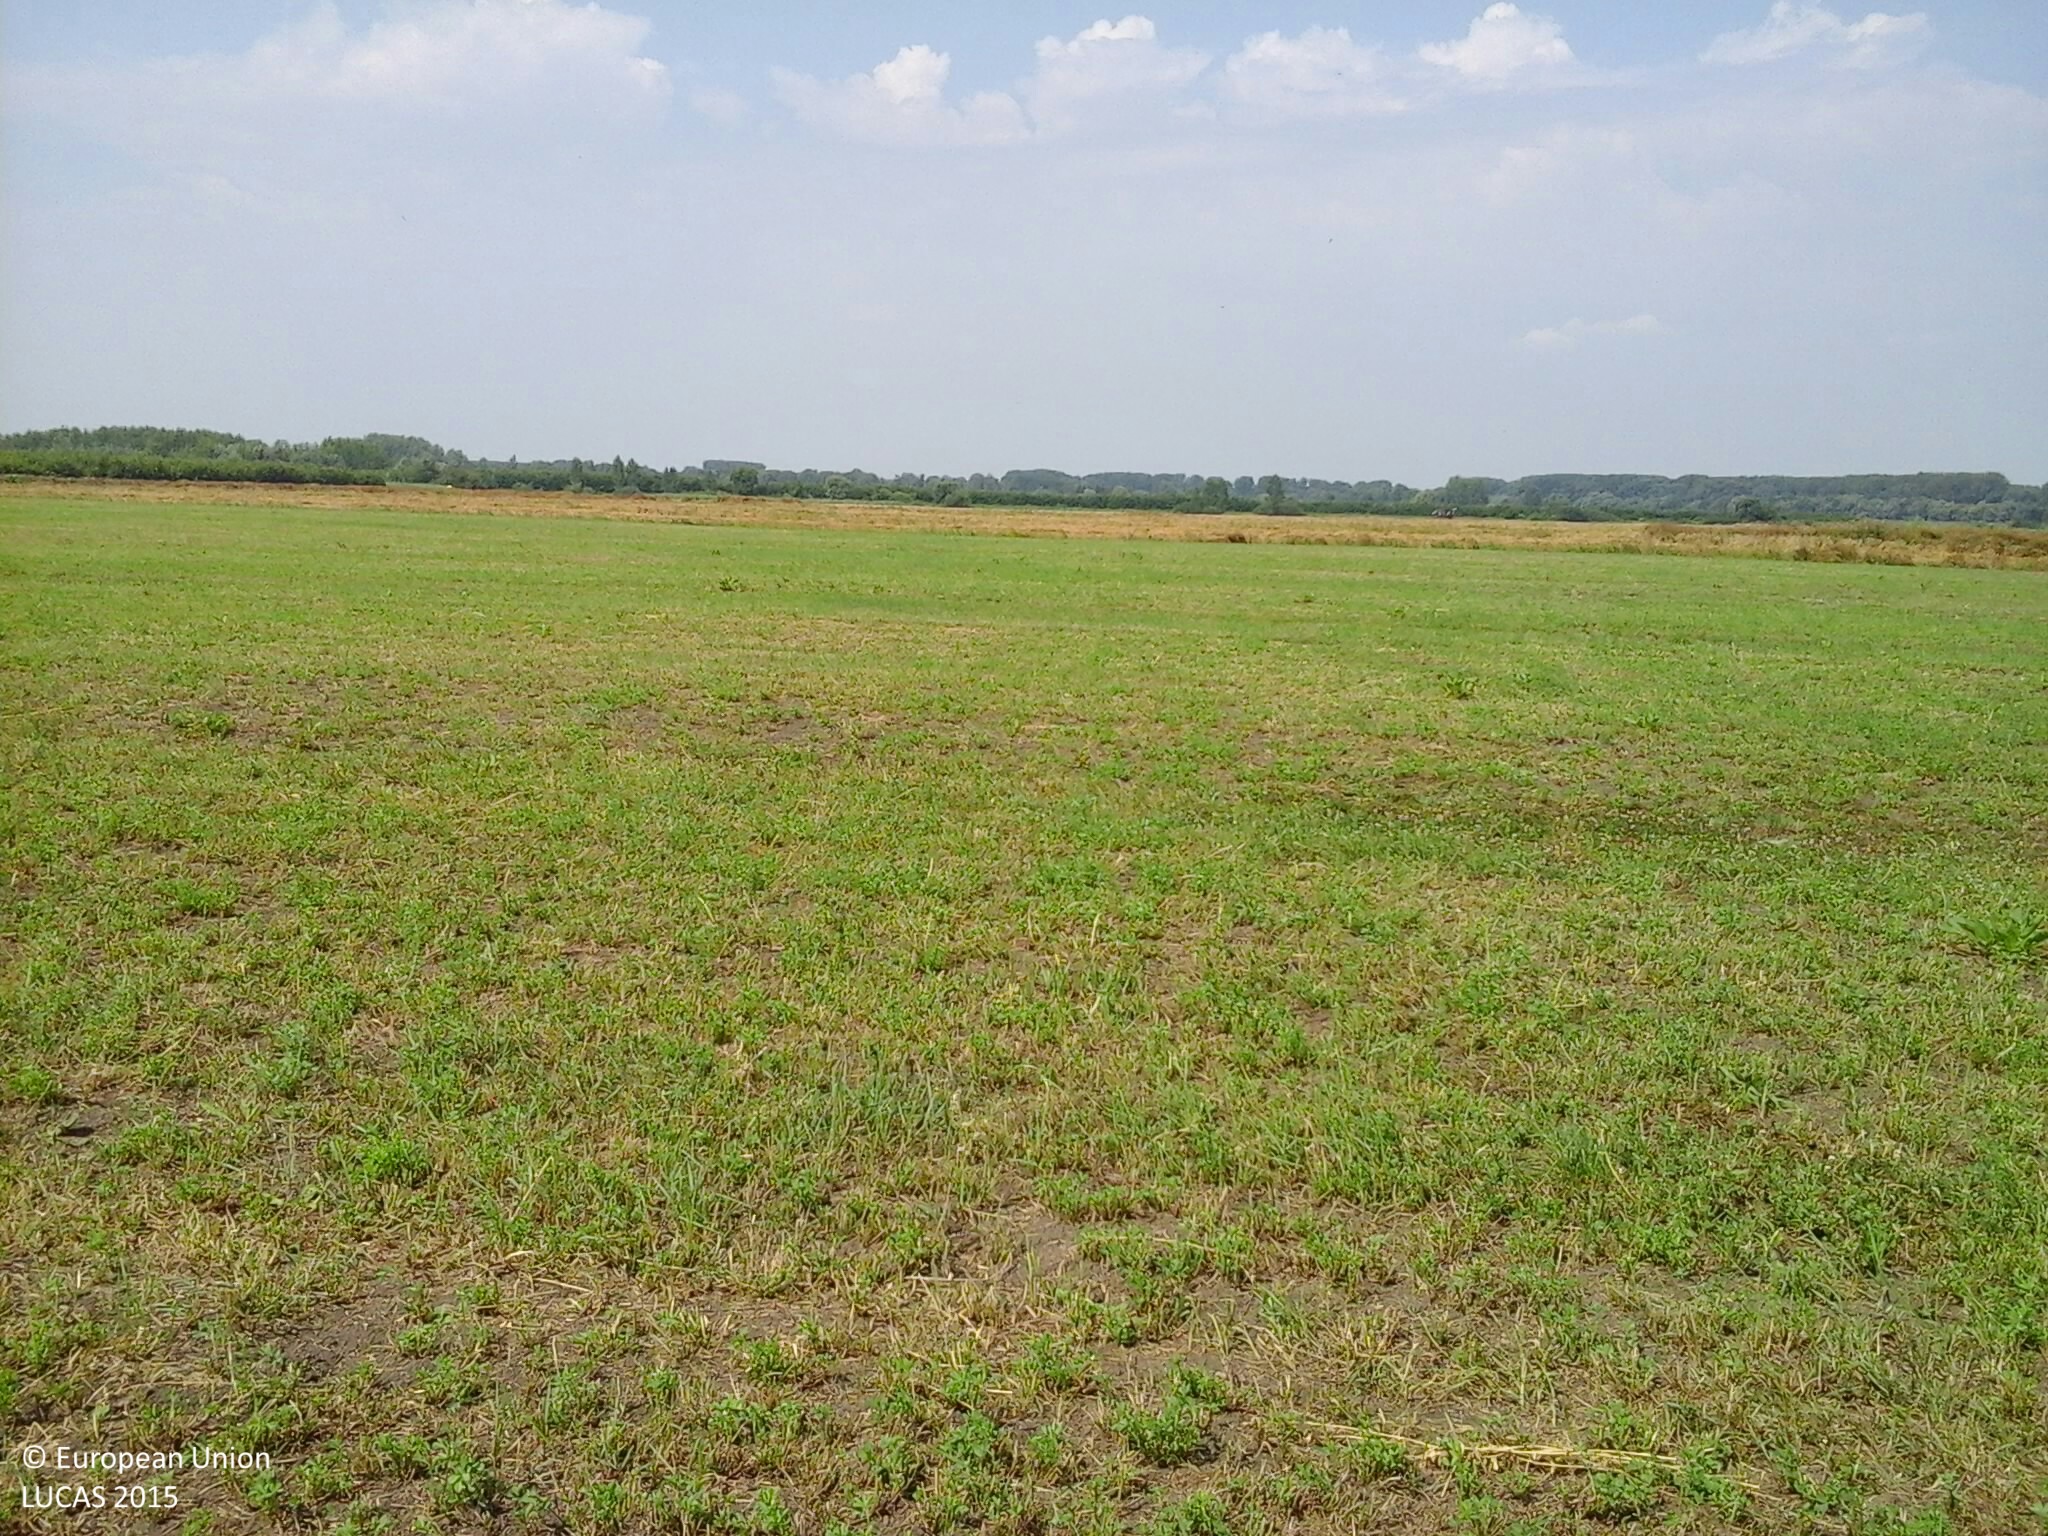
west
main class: Cropland
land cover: Lucerne
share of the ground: 50 - 75 %
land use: Agriculture (excluding fallow land and kitchen gardens)
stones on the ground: < 10 %
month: August
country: HU
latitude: 47.7096
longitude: 20.9798
